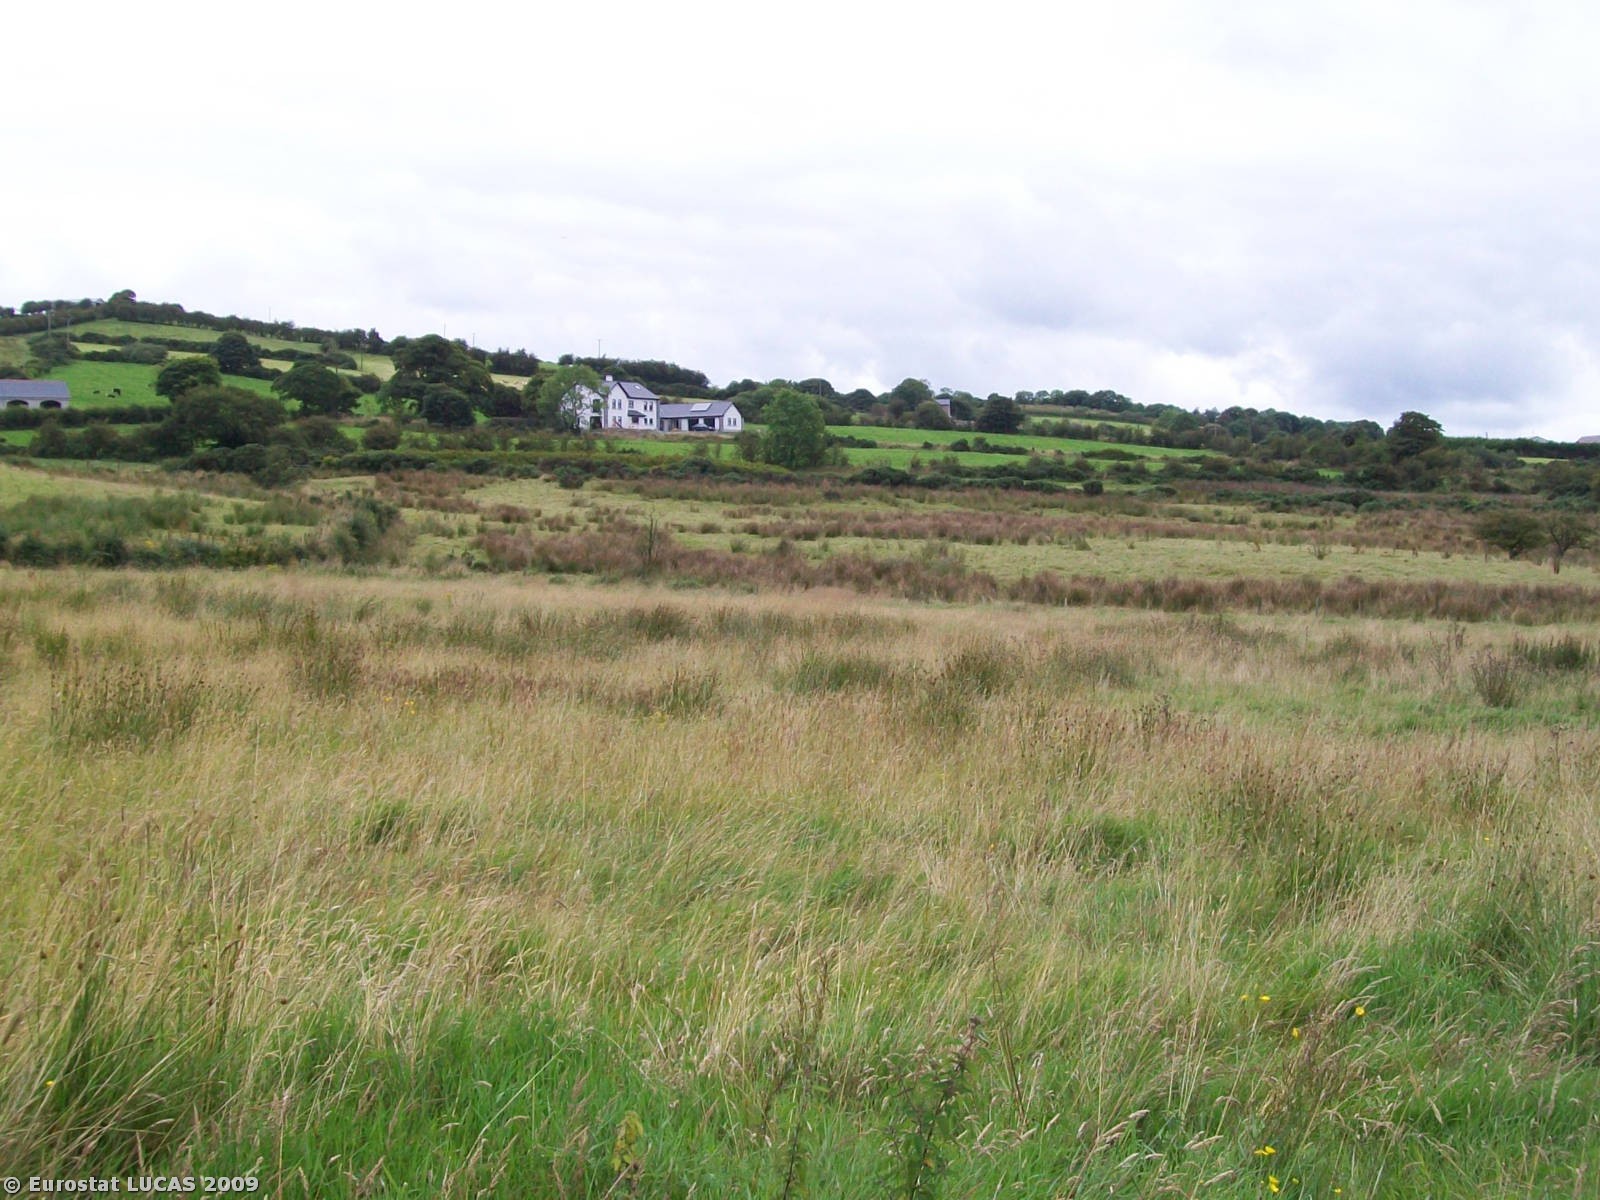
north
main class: Grassland
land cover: Grassland without tree/shrub cover
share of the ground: > 75 %
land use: Agriculture (excluding fallow land and kitchen gardens)
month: August
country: GB
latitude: 54.1968
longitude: -6.5744
